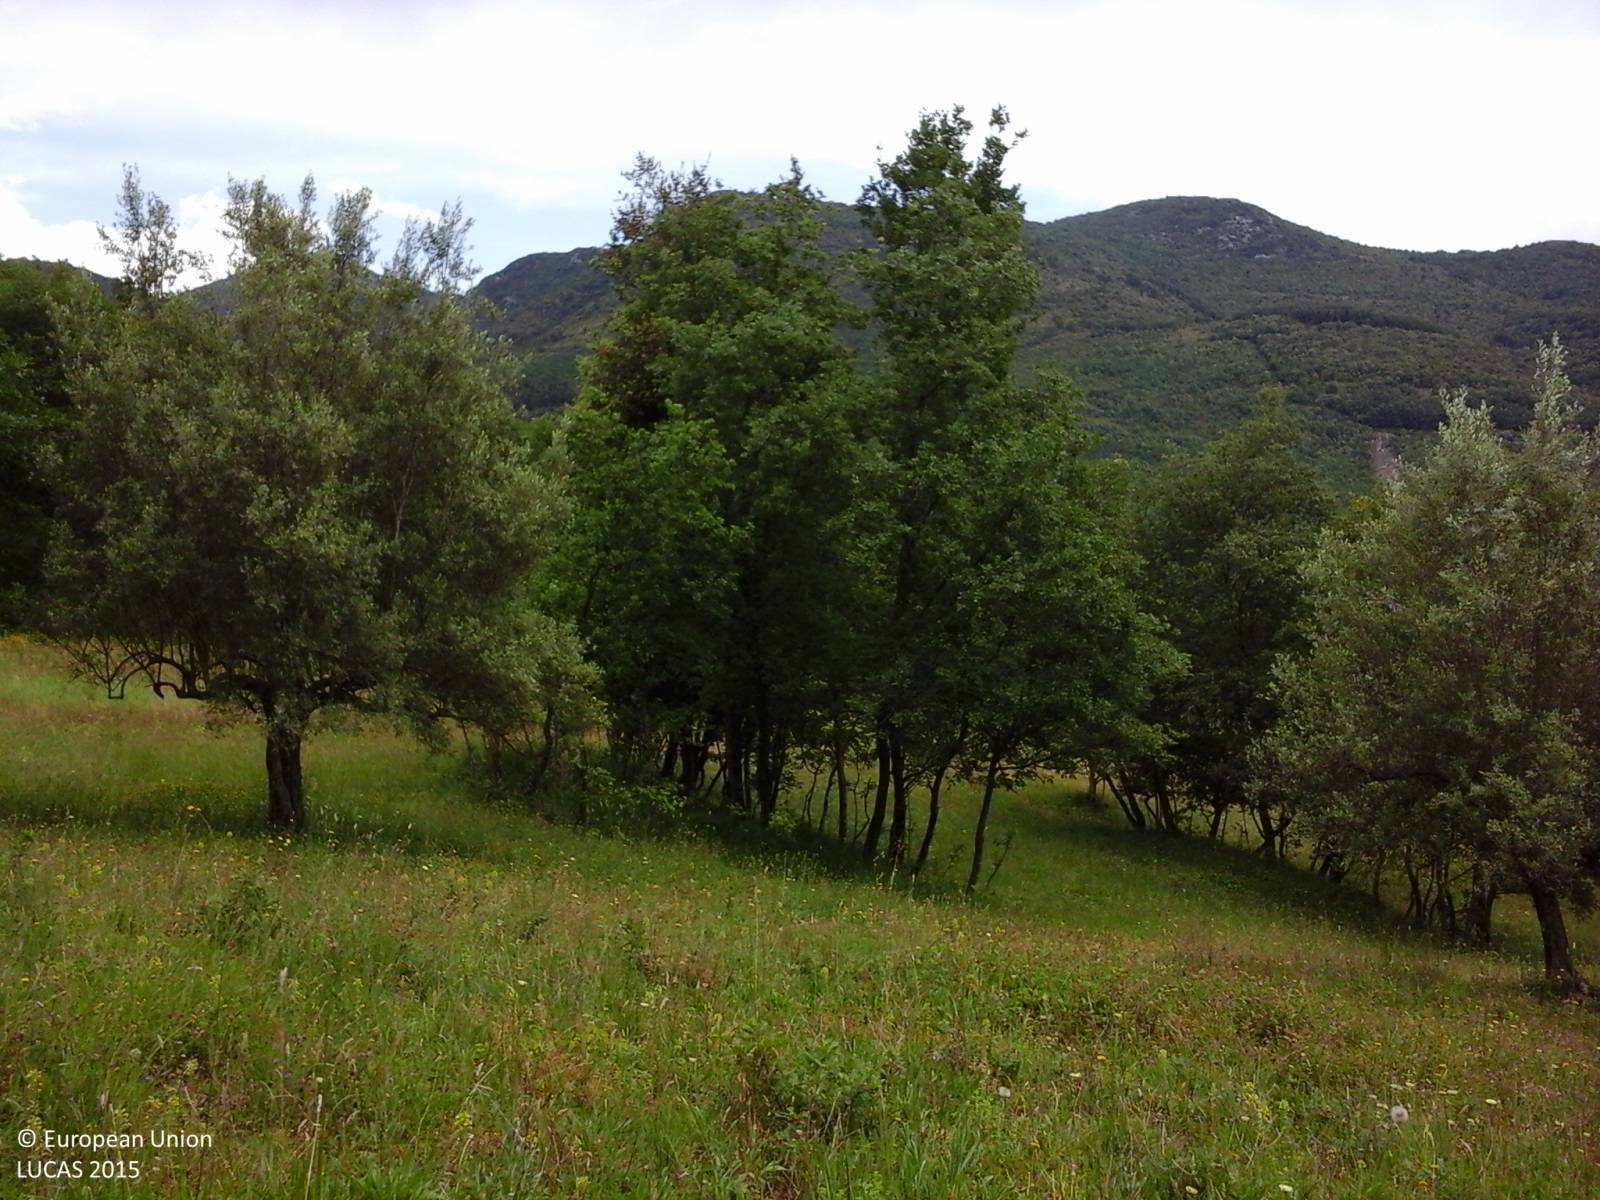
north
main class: Woodland
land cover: Broadleaved woodland
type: thermophilous deciduous forest
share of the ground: > 75 %
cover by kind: broadleaved forest trees 100 %
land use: Forestry
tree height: < 5 m
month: May
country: IT
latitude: 41.2092
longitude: 14.2174
